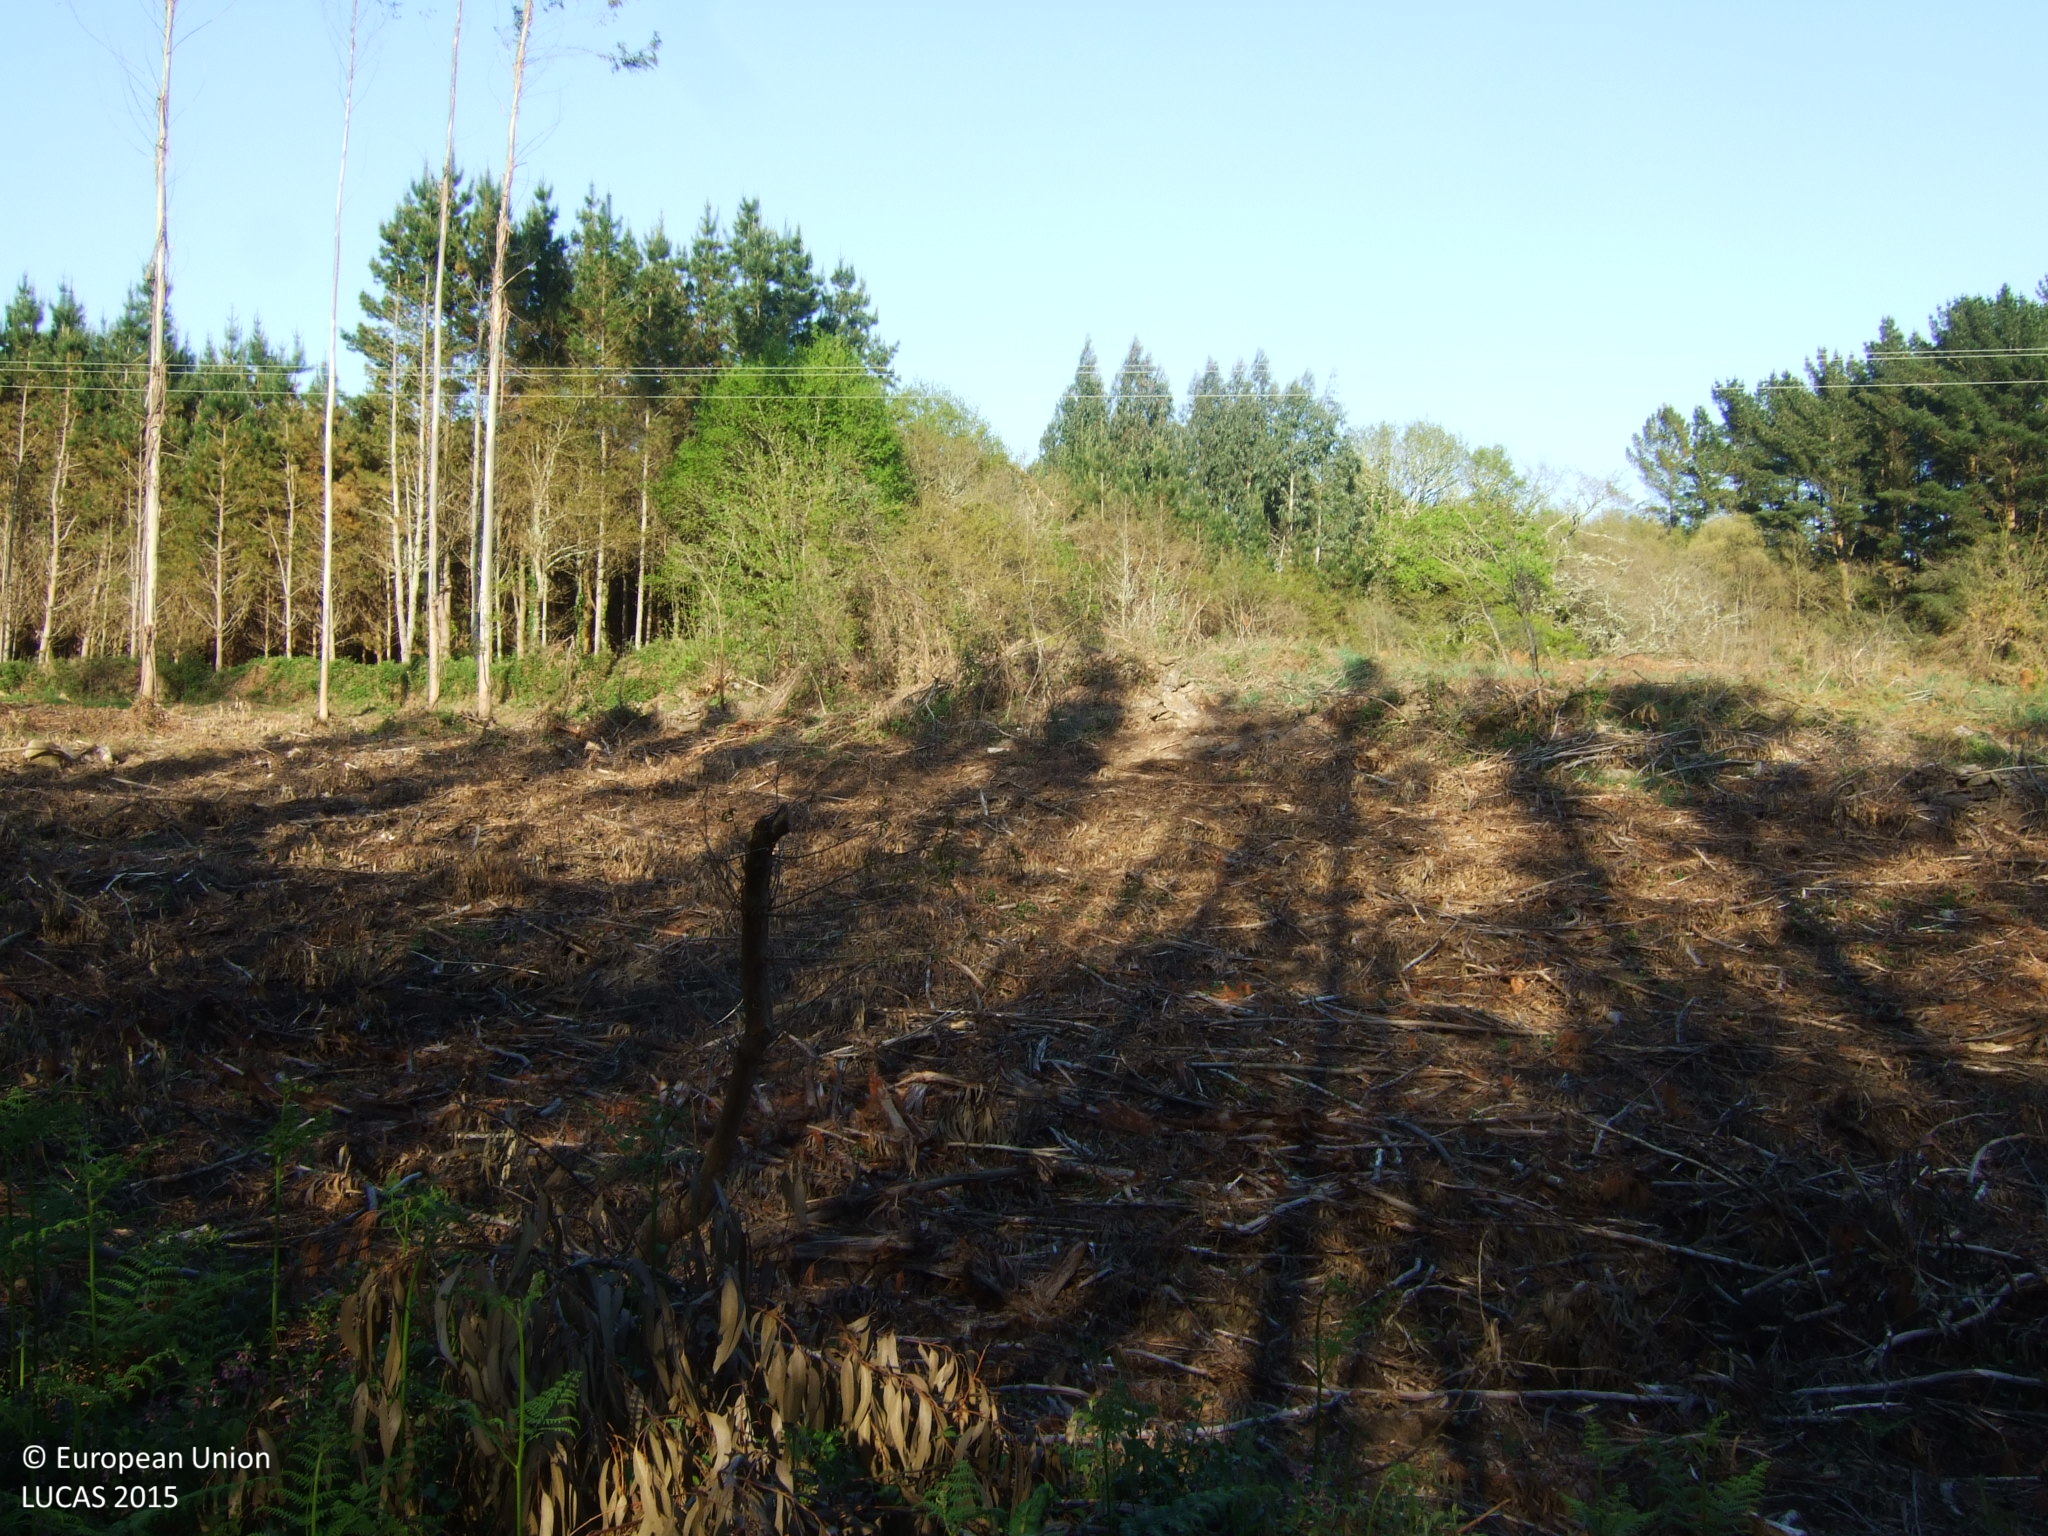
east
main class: Woodland
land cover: Pine dominated coniferous woodland
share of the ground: 25 - 50 %
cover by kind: coniferous forest trees 50 %, herbaceous plants 30 %, shrubs 10 %, consolidated bare surface 10 %
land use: Forestry
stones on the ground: < 10 %
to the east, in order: Pine dominated coniferous woodland; Grassland without tree/shrub cover; Other bare soil; Grassland without tree/shrub cover; Electric lines; Grassland without tree/shrub cover; Other bare soil; Shrubland without tree cover; Dry stone walls; Broadleaved woodland; Dry stone walls; Tracks; Dry stone walls; Other bare soil
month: April
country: ES
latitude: 43.0838
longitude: -7.6333
